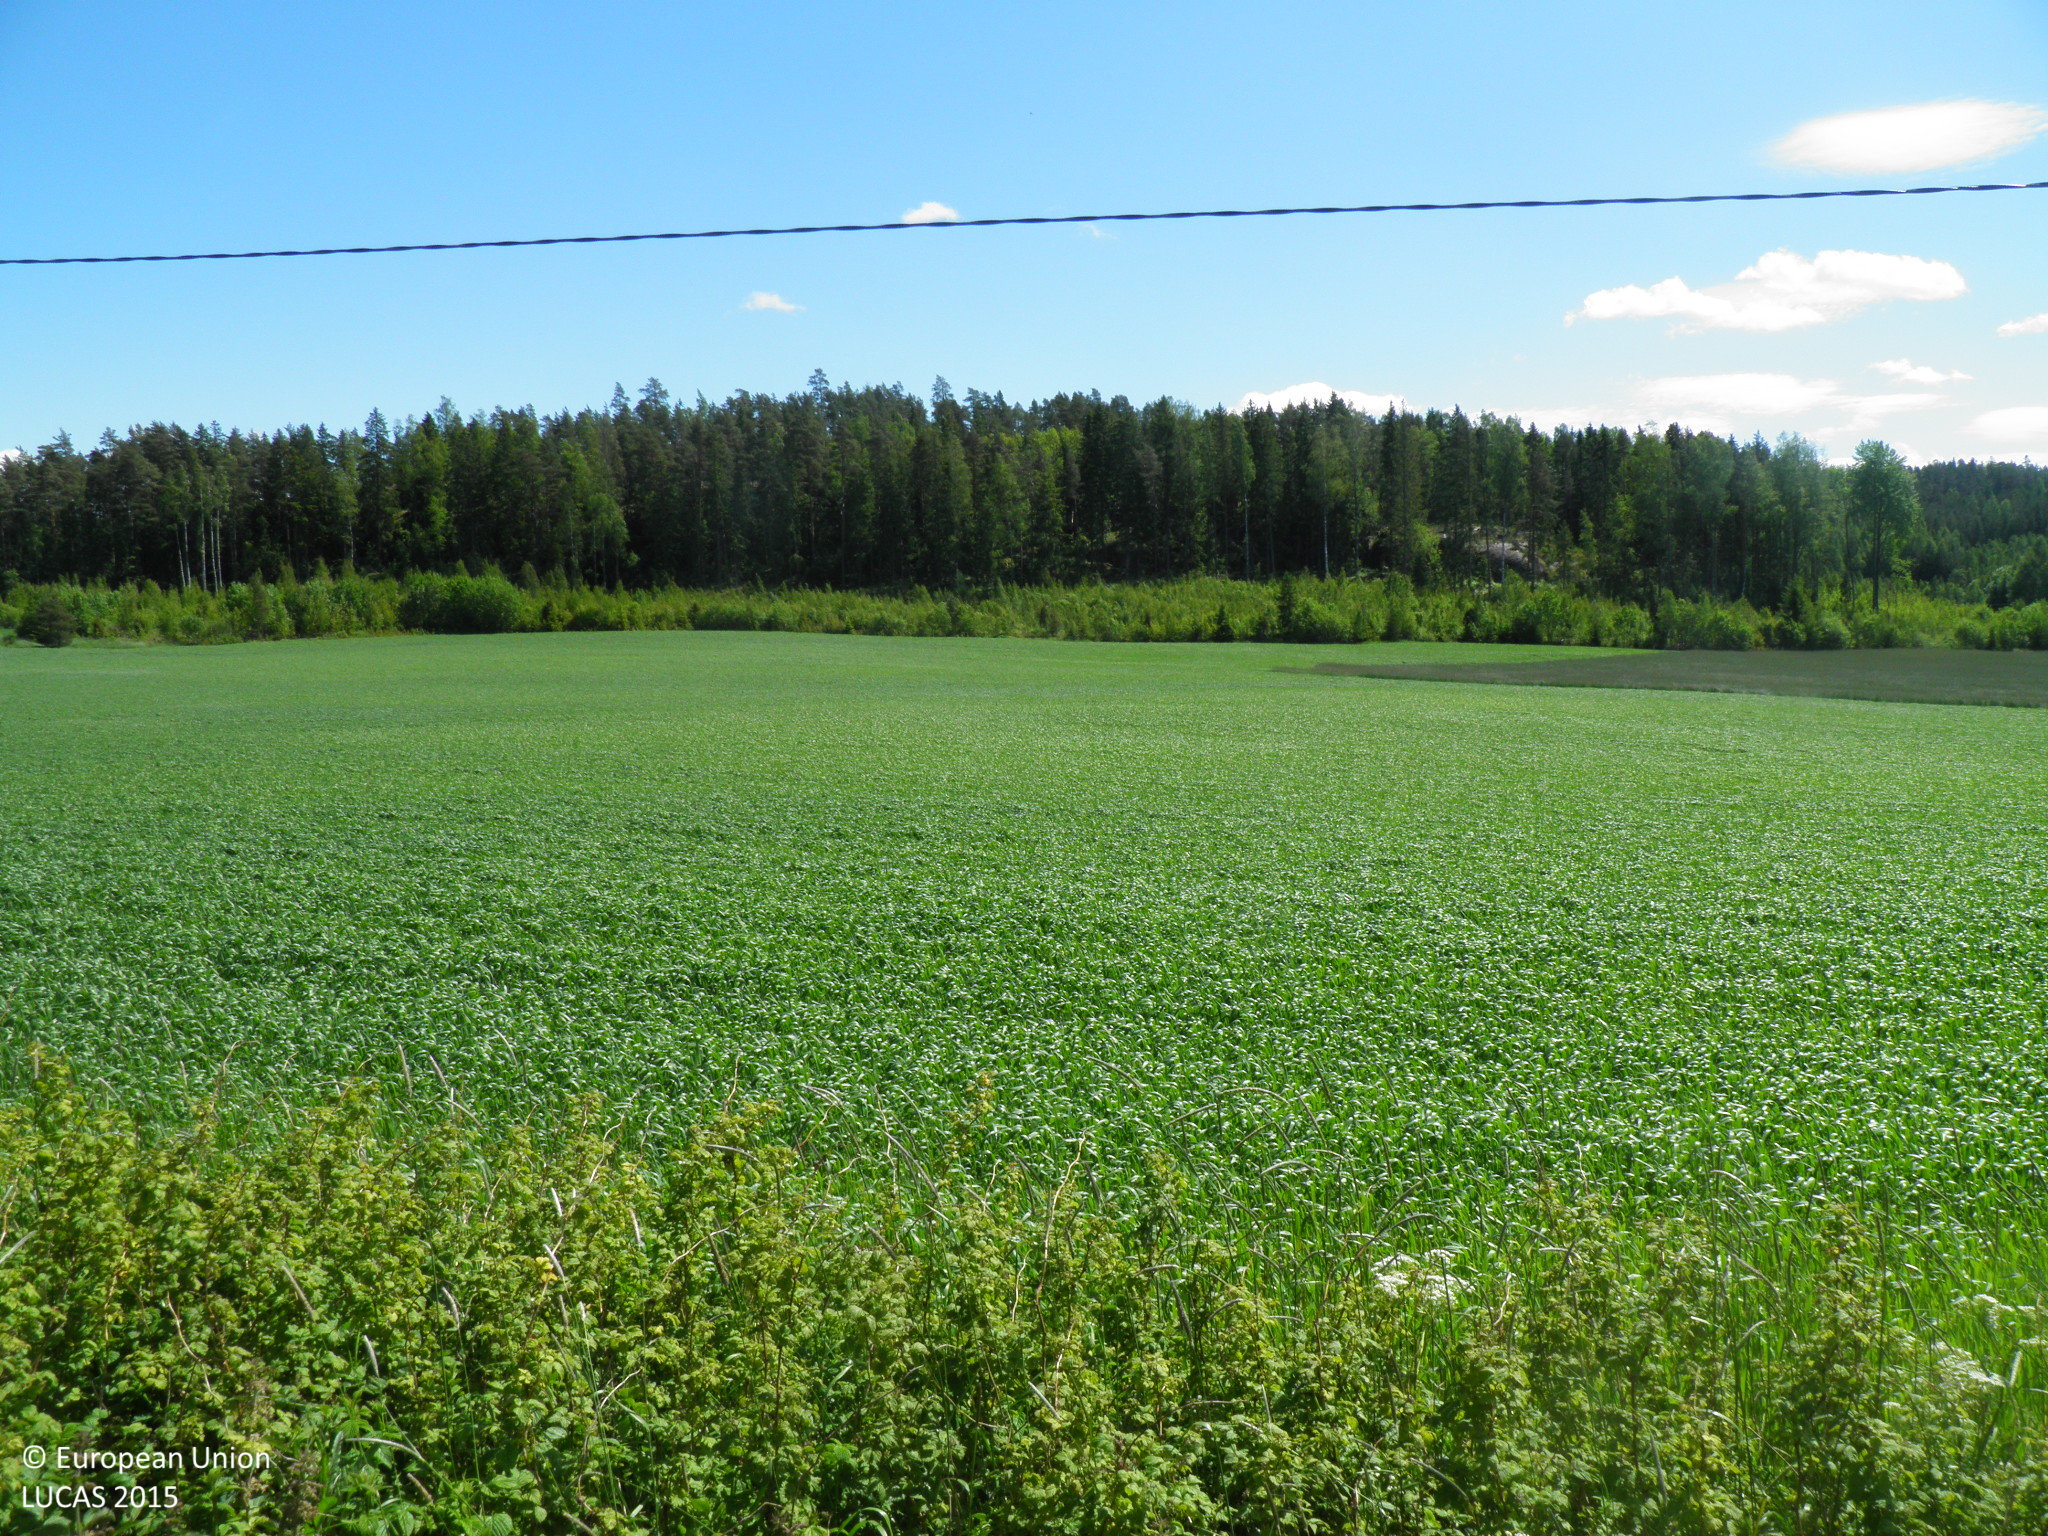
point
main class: Cropland
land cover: Common wheat
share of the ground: > 75 %
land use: Agriculture (excluding fallow land and kitchen gardens)
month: June
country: FI
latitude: 60.3522
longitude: 22.7061
